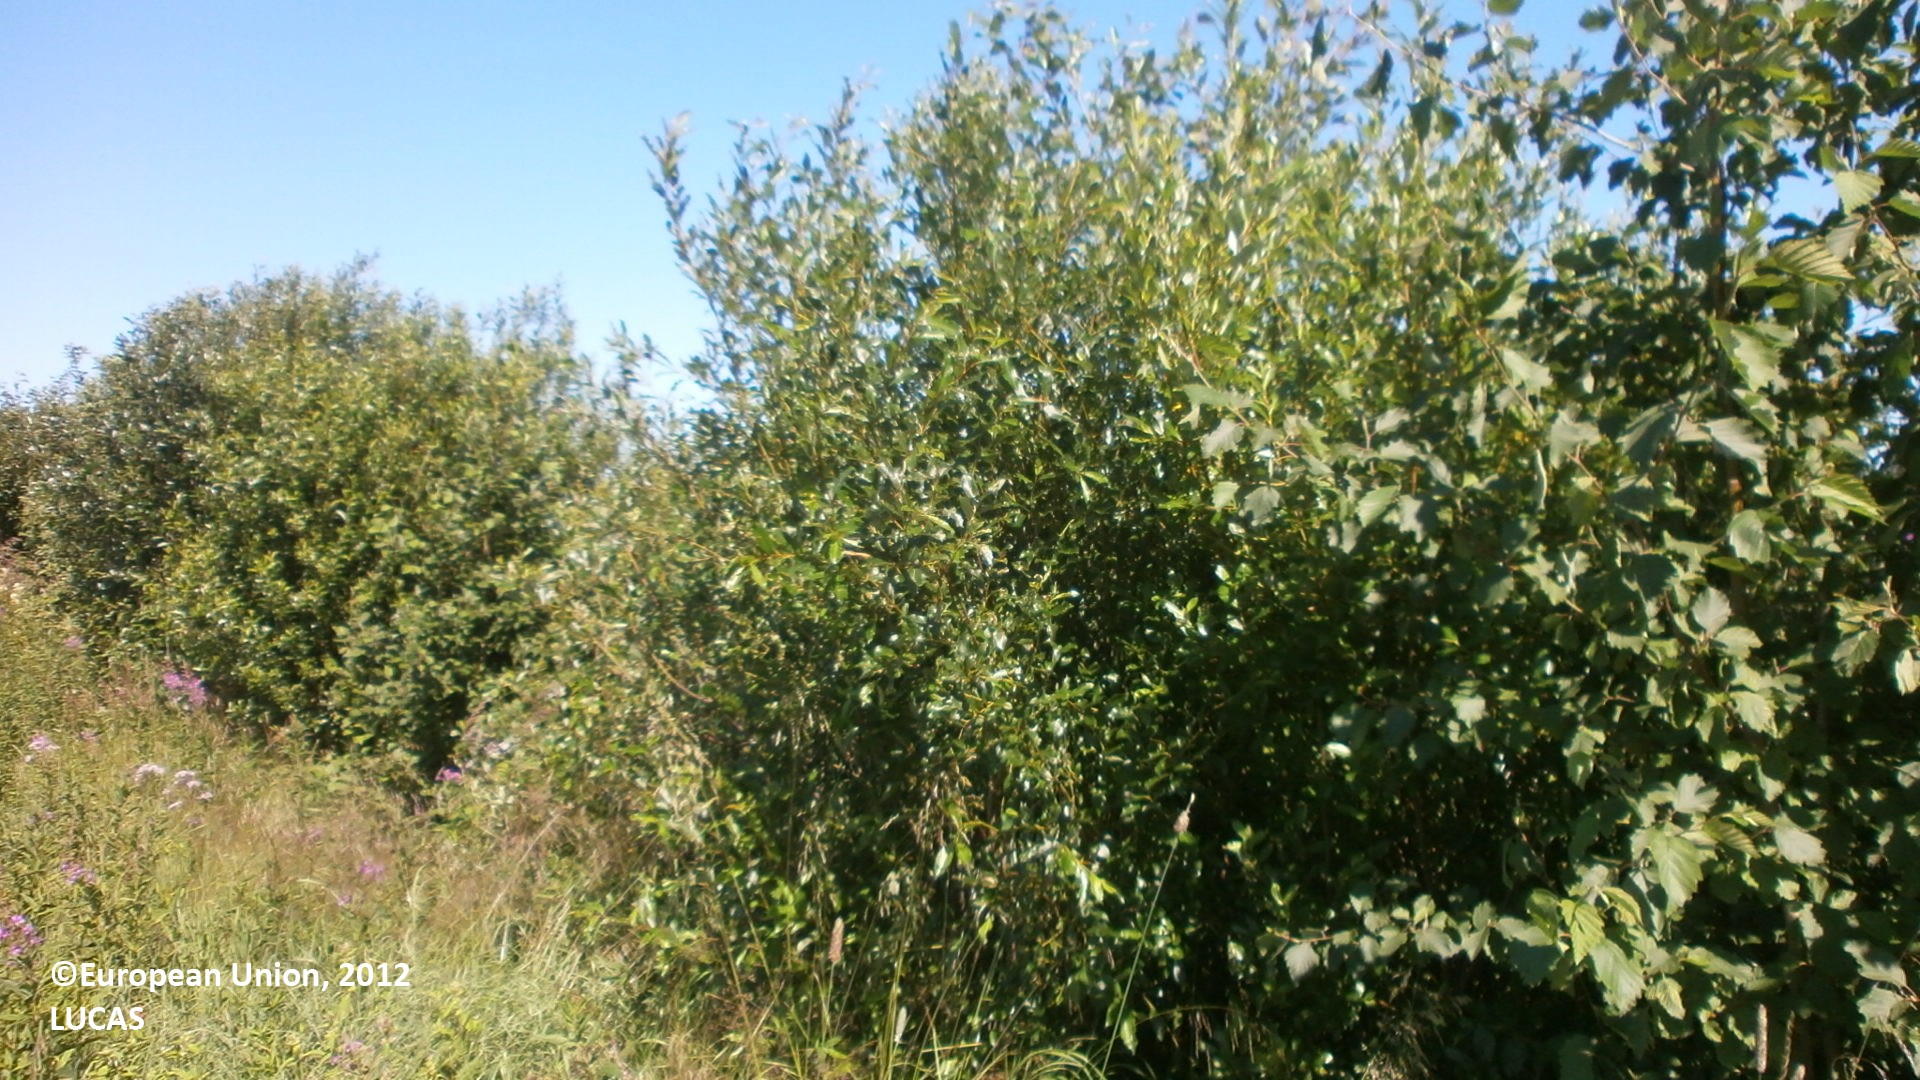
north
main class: Cropland
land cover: Barley
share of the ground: > 75 %
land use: Agriculture (excluding fallow land and kitchen gardens)
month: July
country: FI
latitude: 64.1227
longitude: 23.7992
